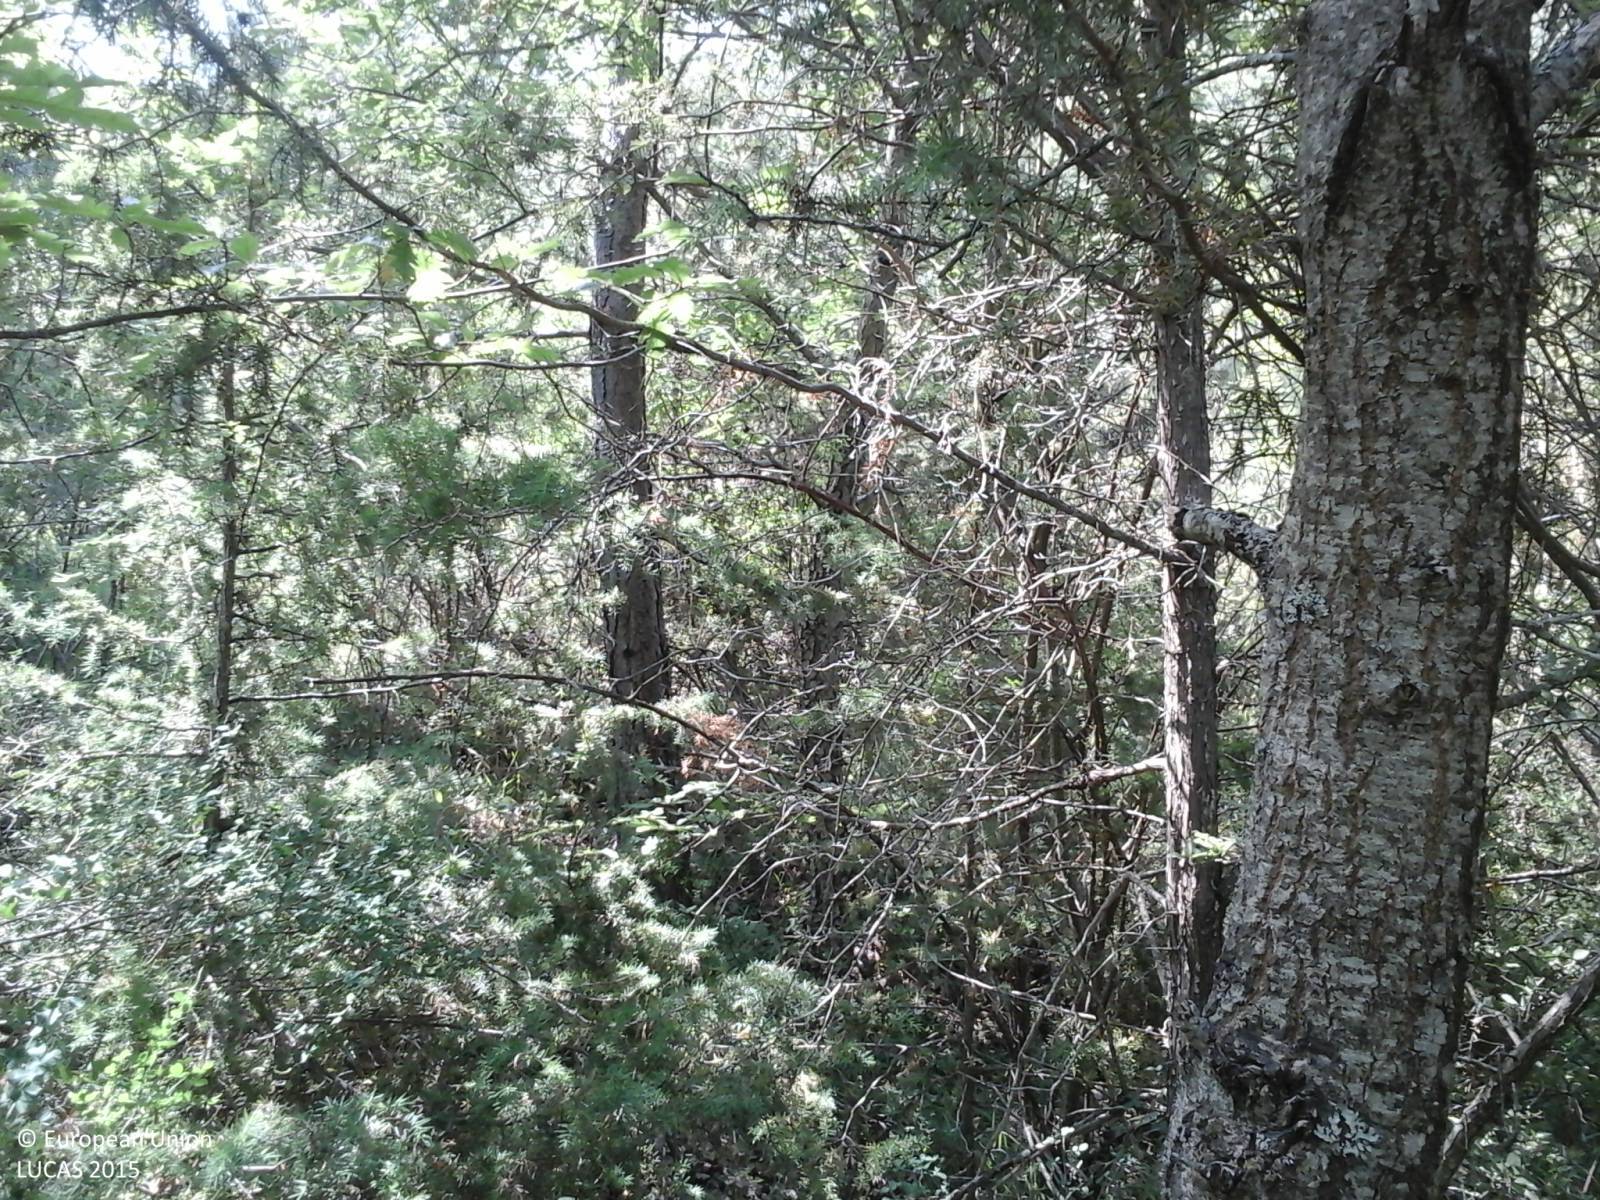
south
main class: Woodland
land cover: Broadleaved woodland
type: thermophilous deciduous forest
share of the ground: > 75 %
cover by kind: broadleaved forest trees 85 %, shrubs 10 %, coniferous forest trees 5 %
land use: Semi-natural and natural areas not in use
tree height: > 5 m
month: July
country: IT
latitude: 42.4922
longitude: 13.2869
